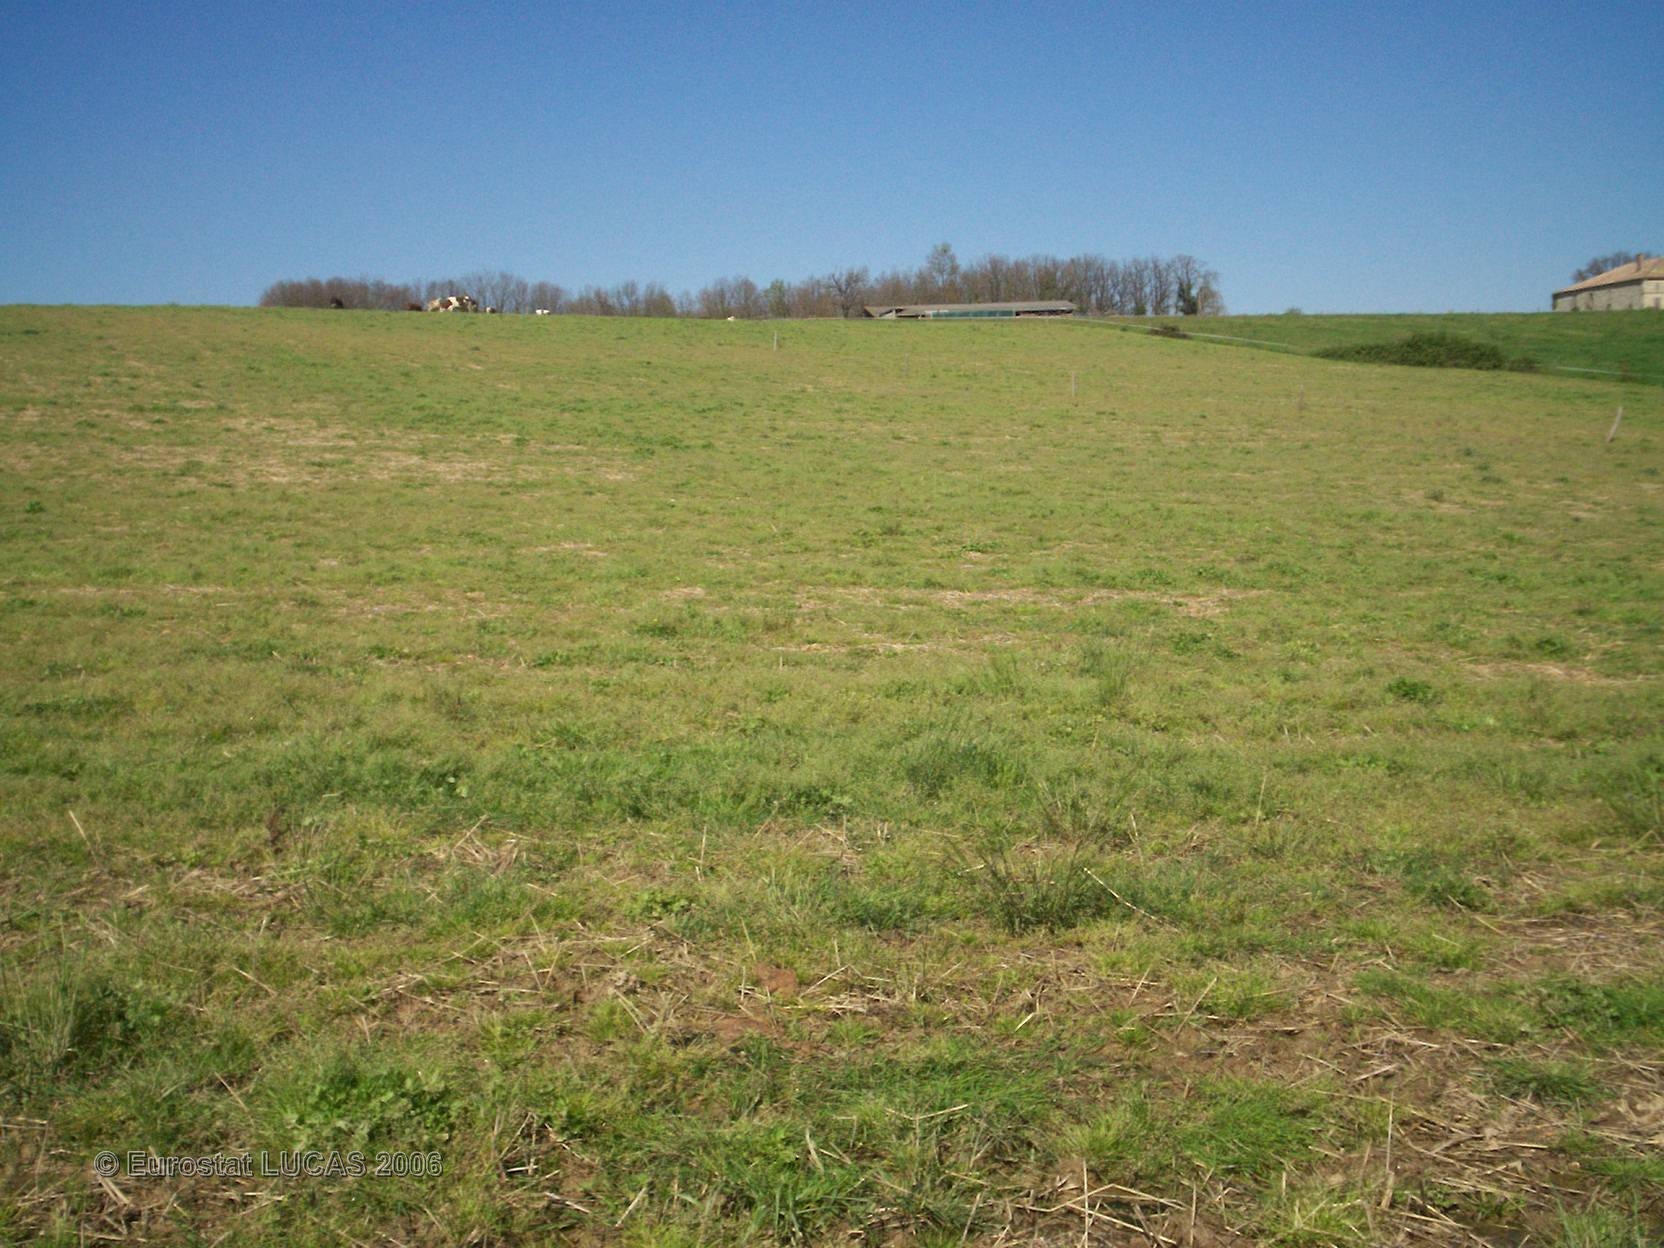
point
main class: Grassland
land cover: Grassland without tree/shrub cover
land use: Agriculture (excluding fallow land and kitchen gardens)
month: April
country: FR
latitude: 44.0250
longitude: 0.9274
